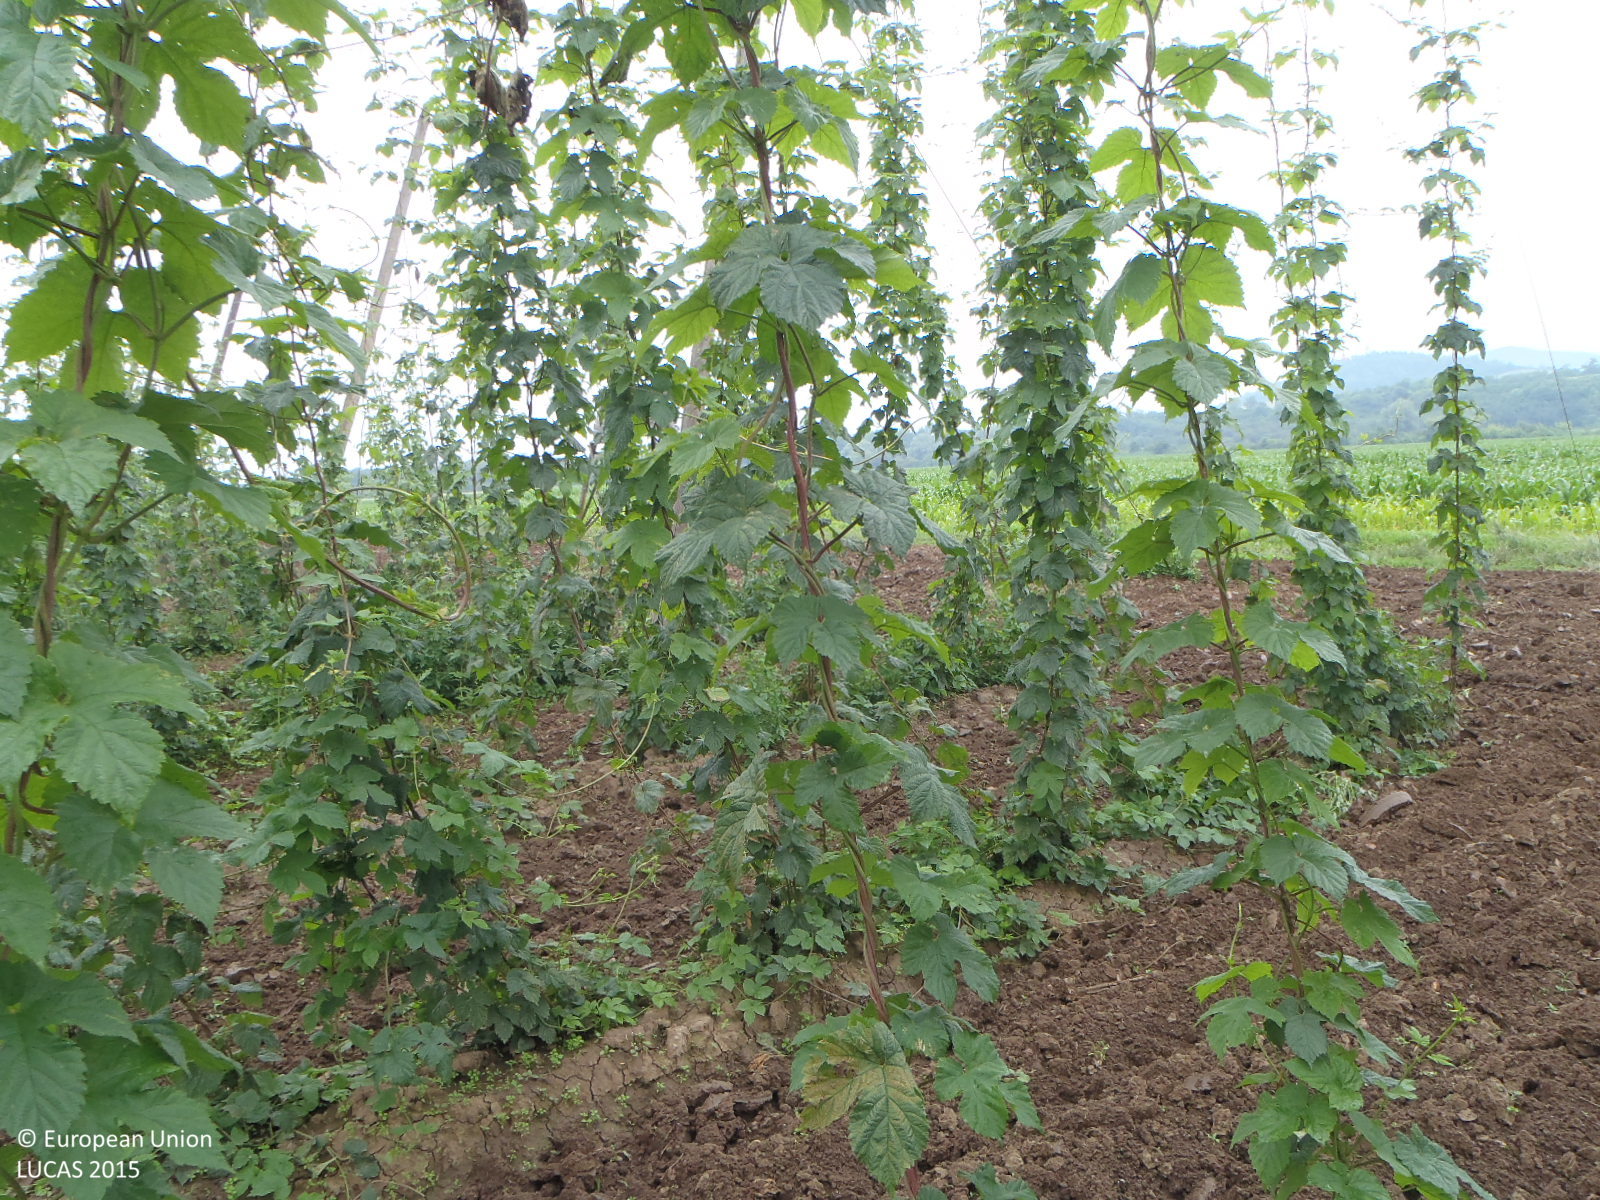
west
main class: Cropland
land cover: Other non-permanent industrial crops
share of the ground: 50 - 75 %
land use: Agriculture (excluding fallow land and kitchen gardens)
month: June
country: CZ
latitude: 50.3726
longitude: 13.8111
